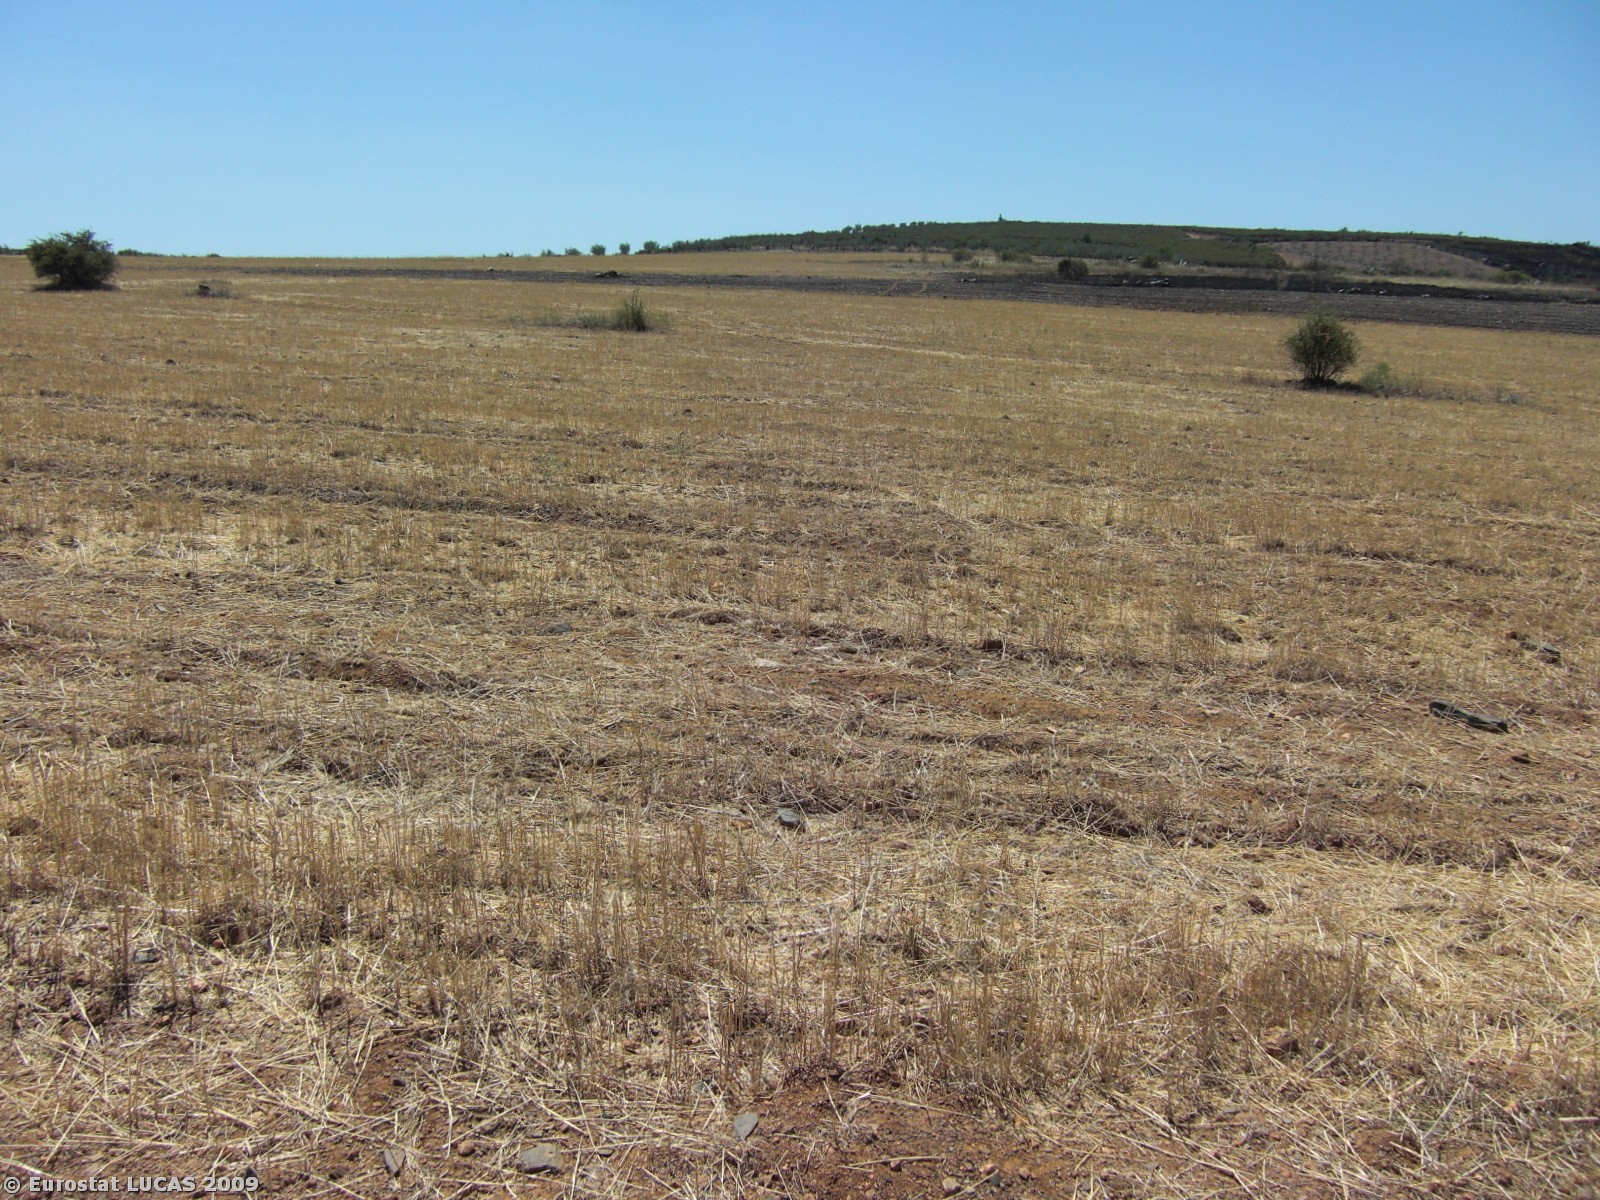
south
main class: Cropland
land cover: Mixed cereals for fodder
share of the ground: < 10 %
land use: Agriculture (excluding fallow land and kitchen gardens)
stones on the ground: > 50 %
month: August
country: PT
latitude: 41.4433
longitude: -6.4627
